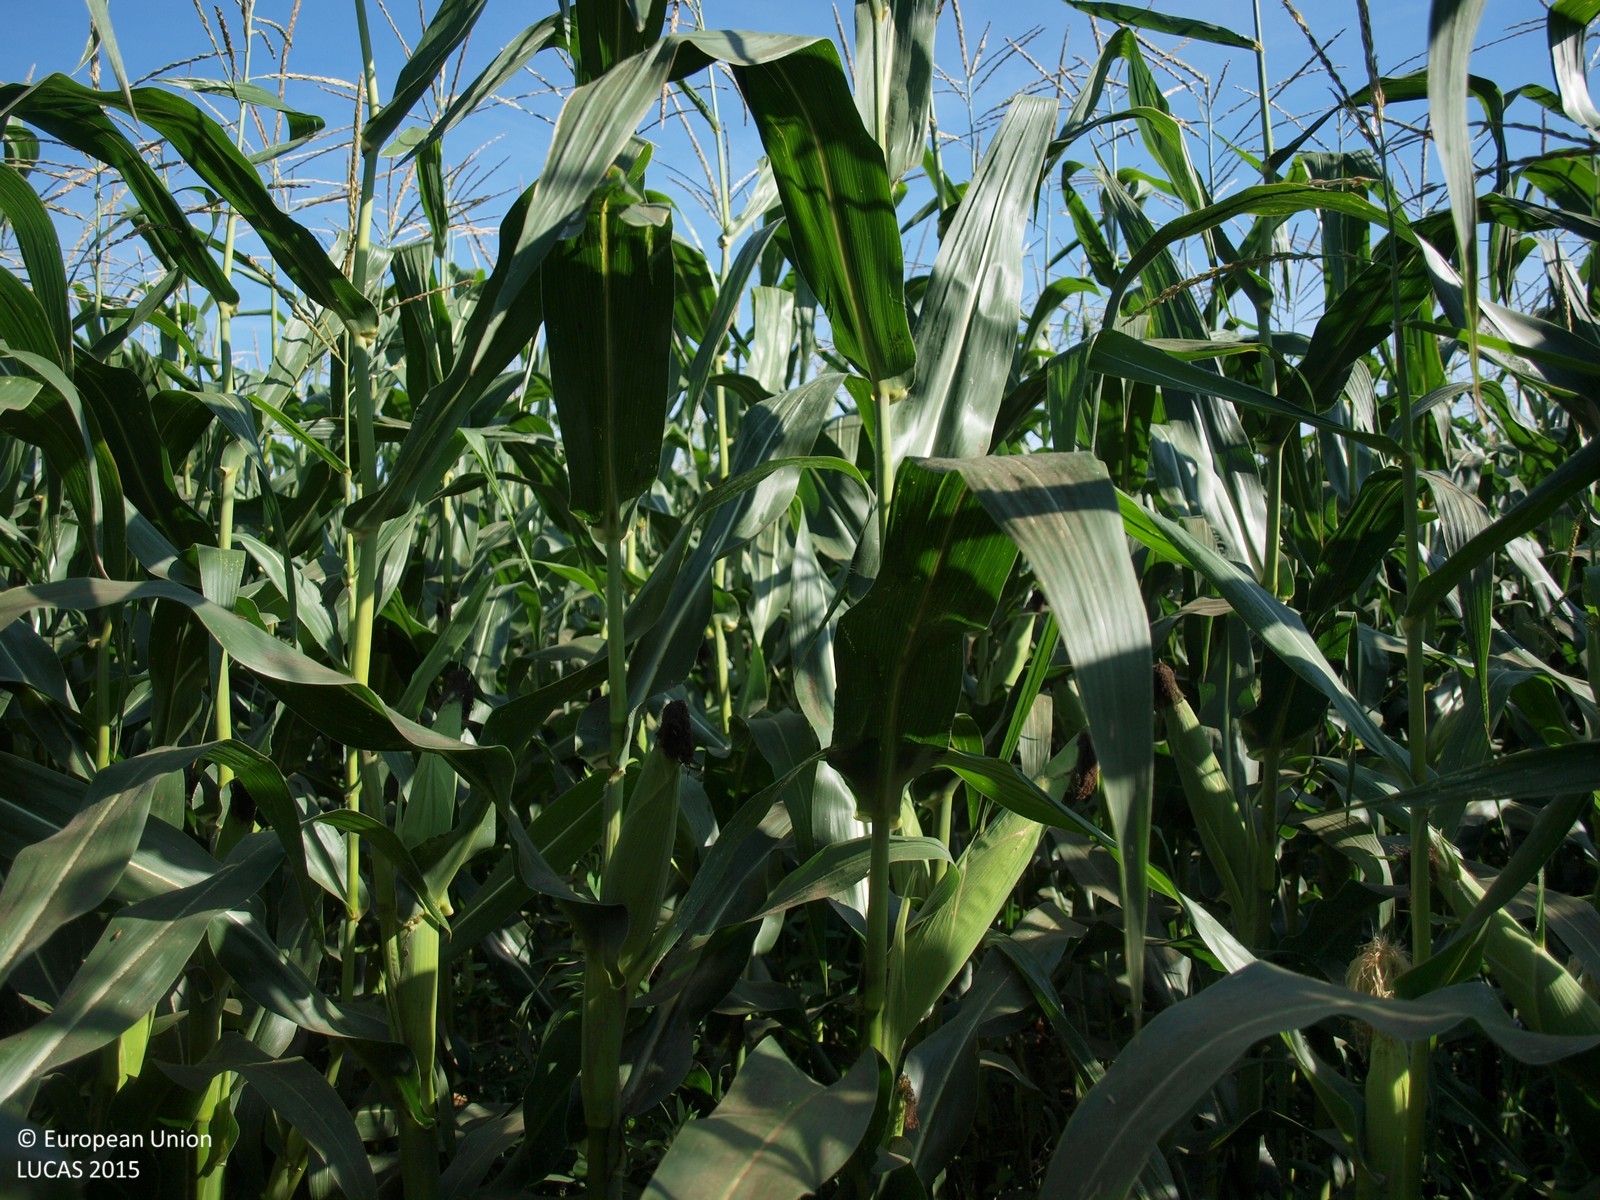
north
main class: Cropland
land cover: Maize
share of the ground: > 75 %
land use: Agriculture (excluding fallow land and kitchen gardens)
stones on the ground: < 10 %
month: August
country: HR
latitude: 46.0036
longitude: 16.2879
